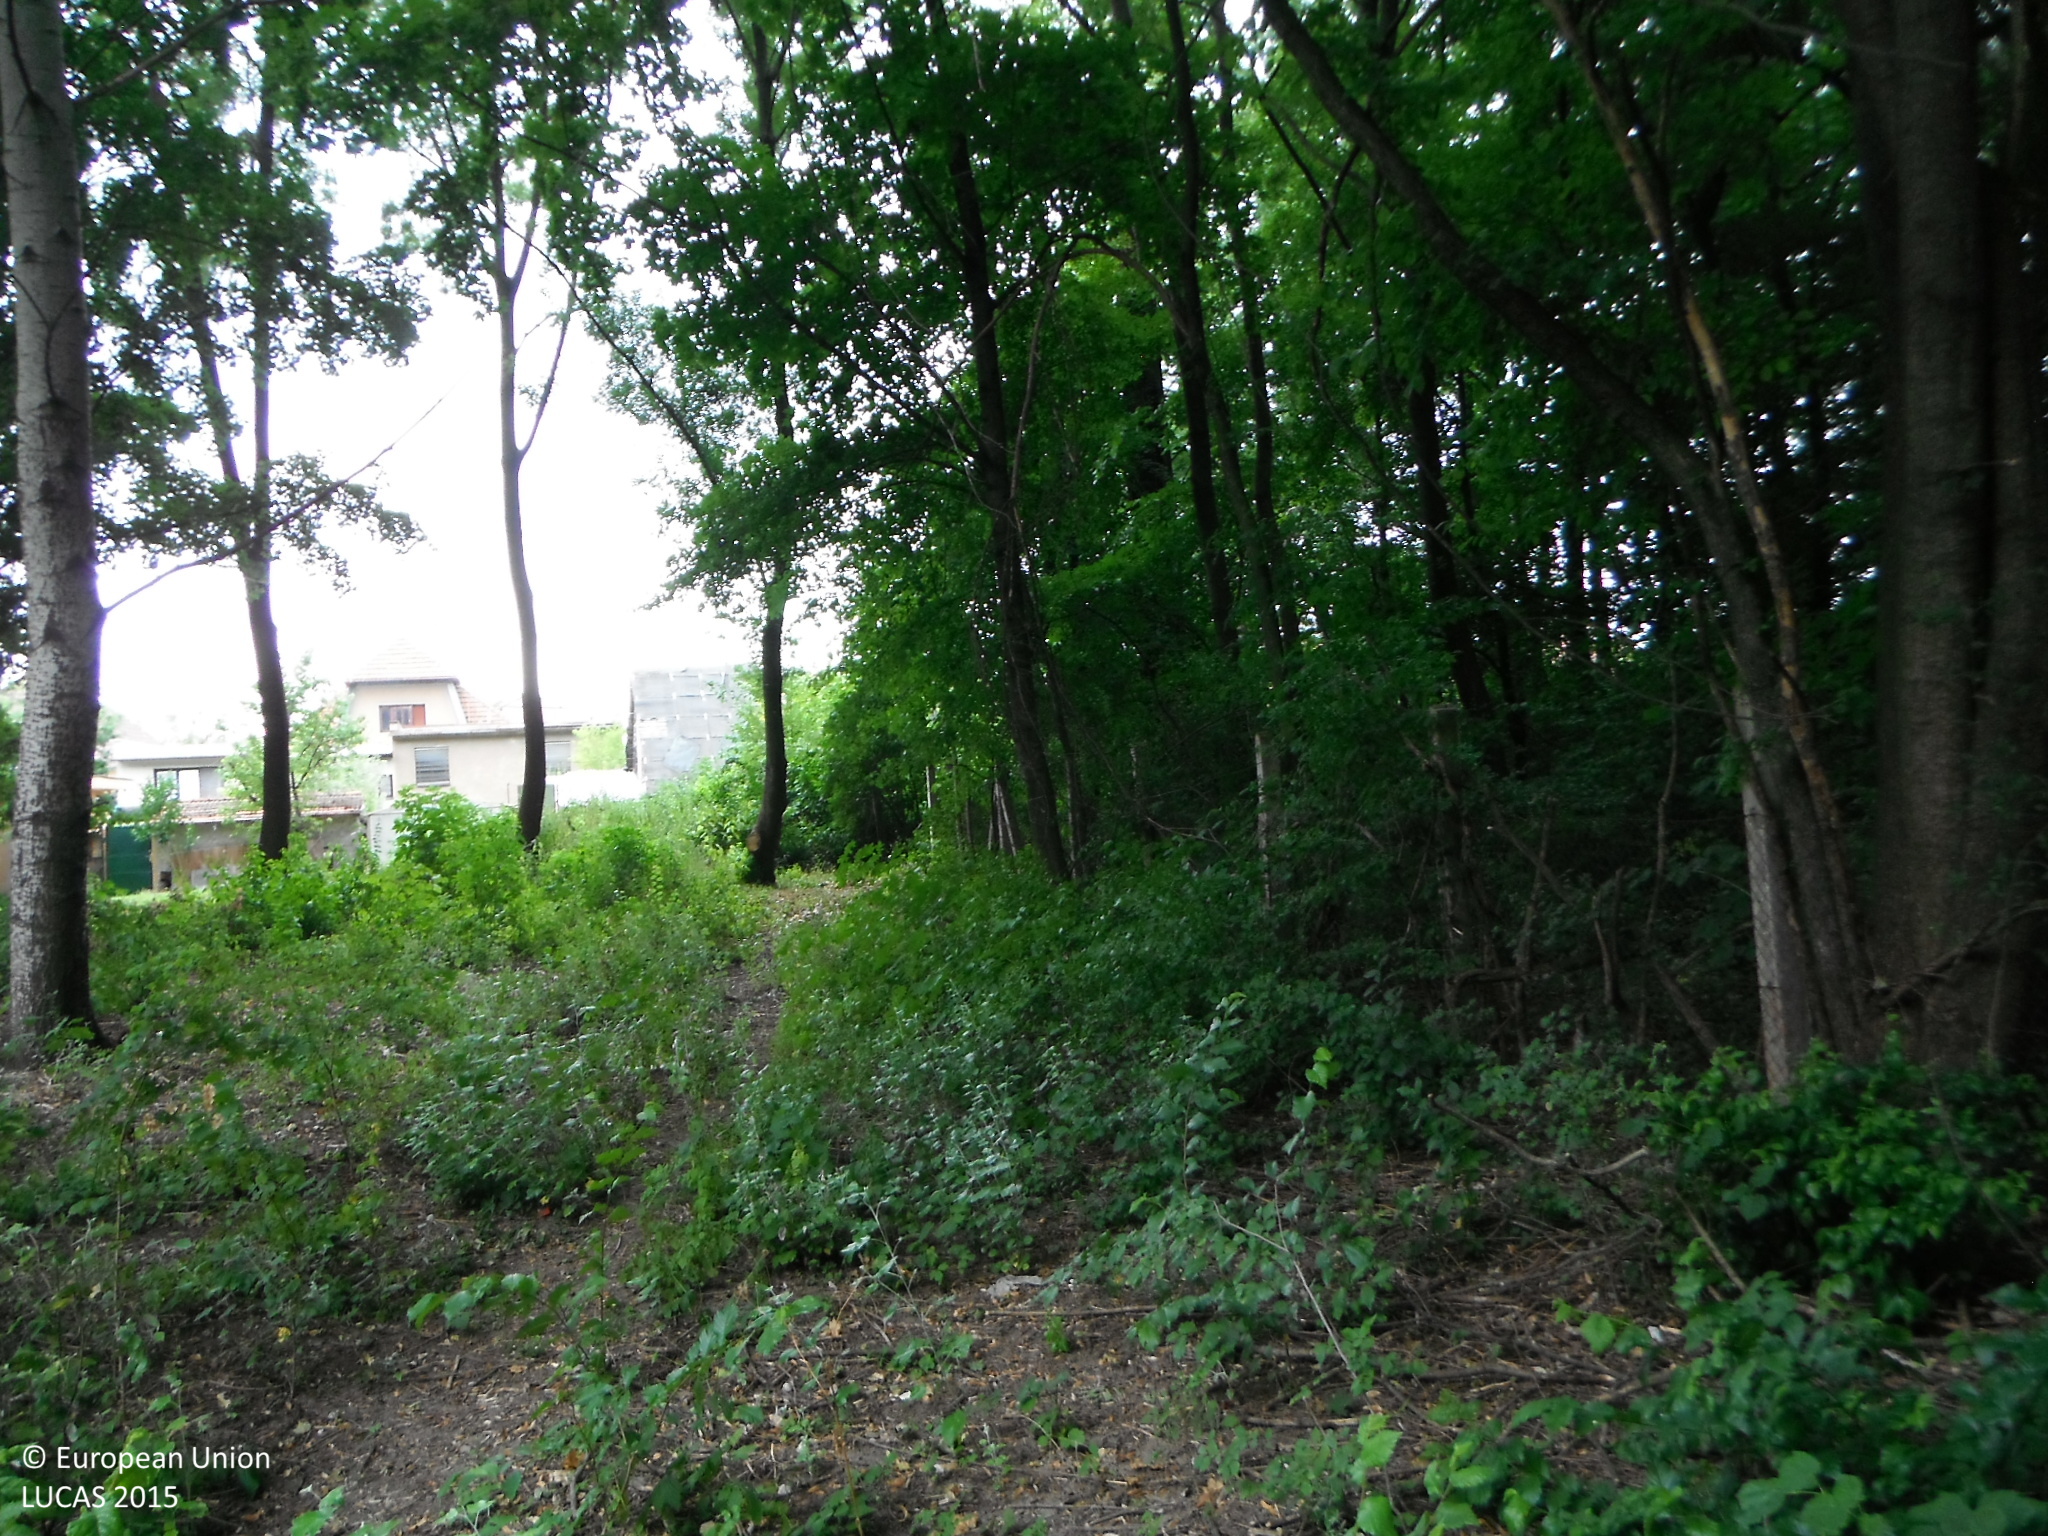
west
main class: Woodland
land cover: Broadleaved woodland
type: mesophytic deciduous forest
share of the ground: 50 - 75 %
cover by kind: broadleaved forest trees 50 %, herbaceous plants 40 %, shrubs 10 %
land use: Amenities, museums, leisure
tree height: > 5 m
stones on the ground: < 10 %
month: July
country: SK
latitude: 48.6311
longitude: 18.3336
